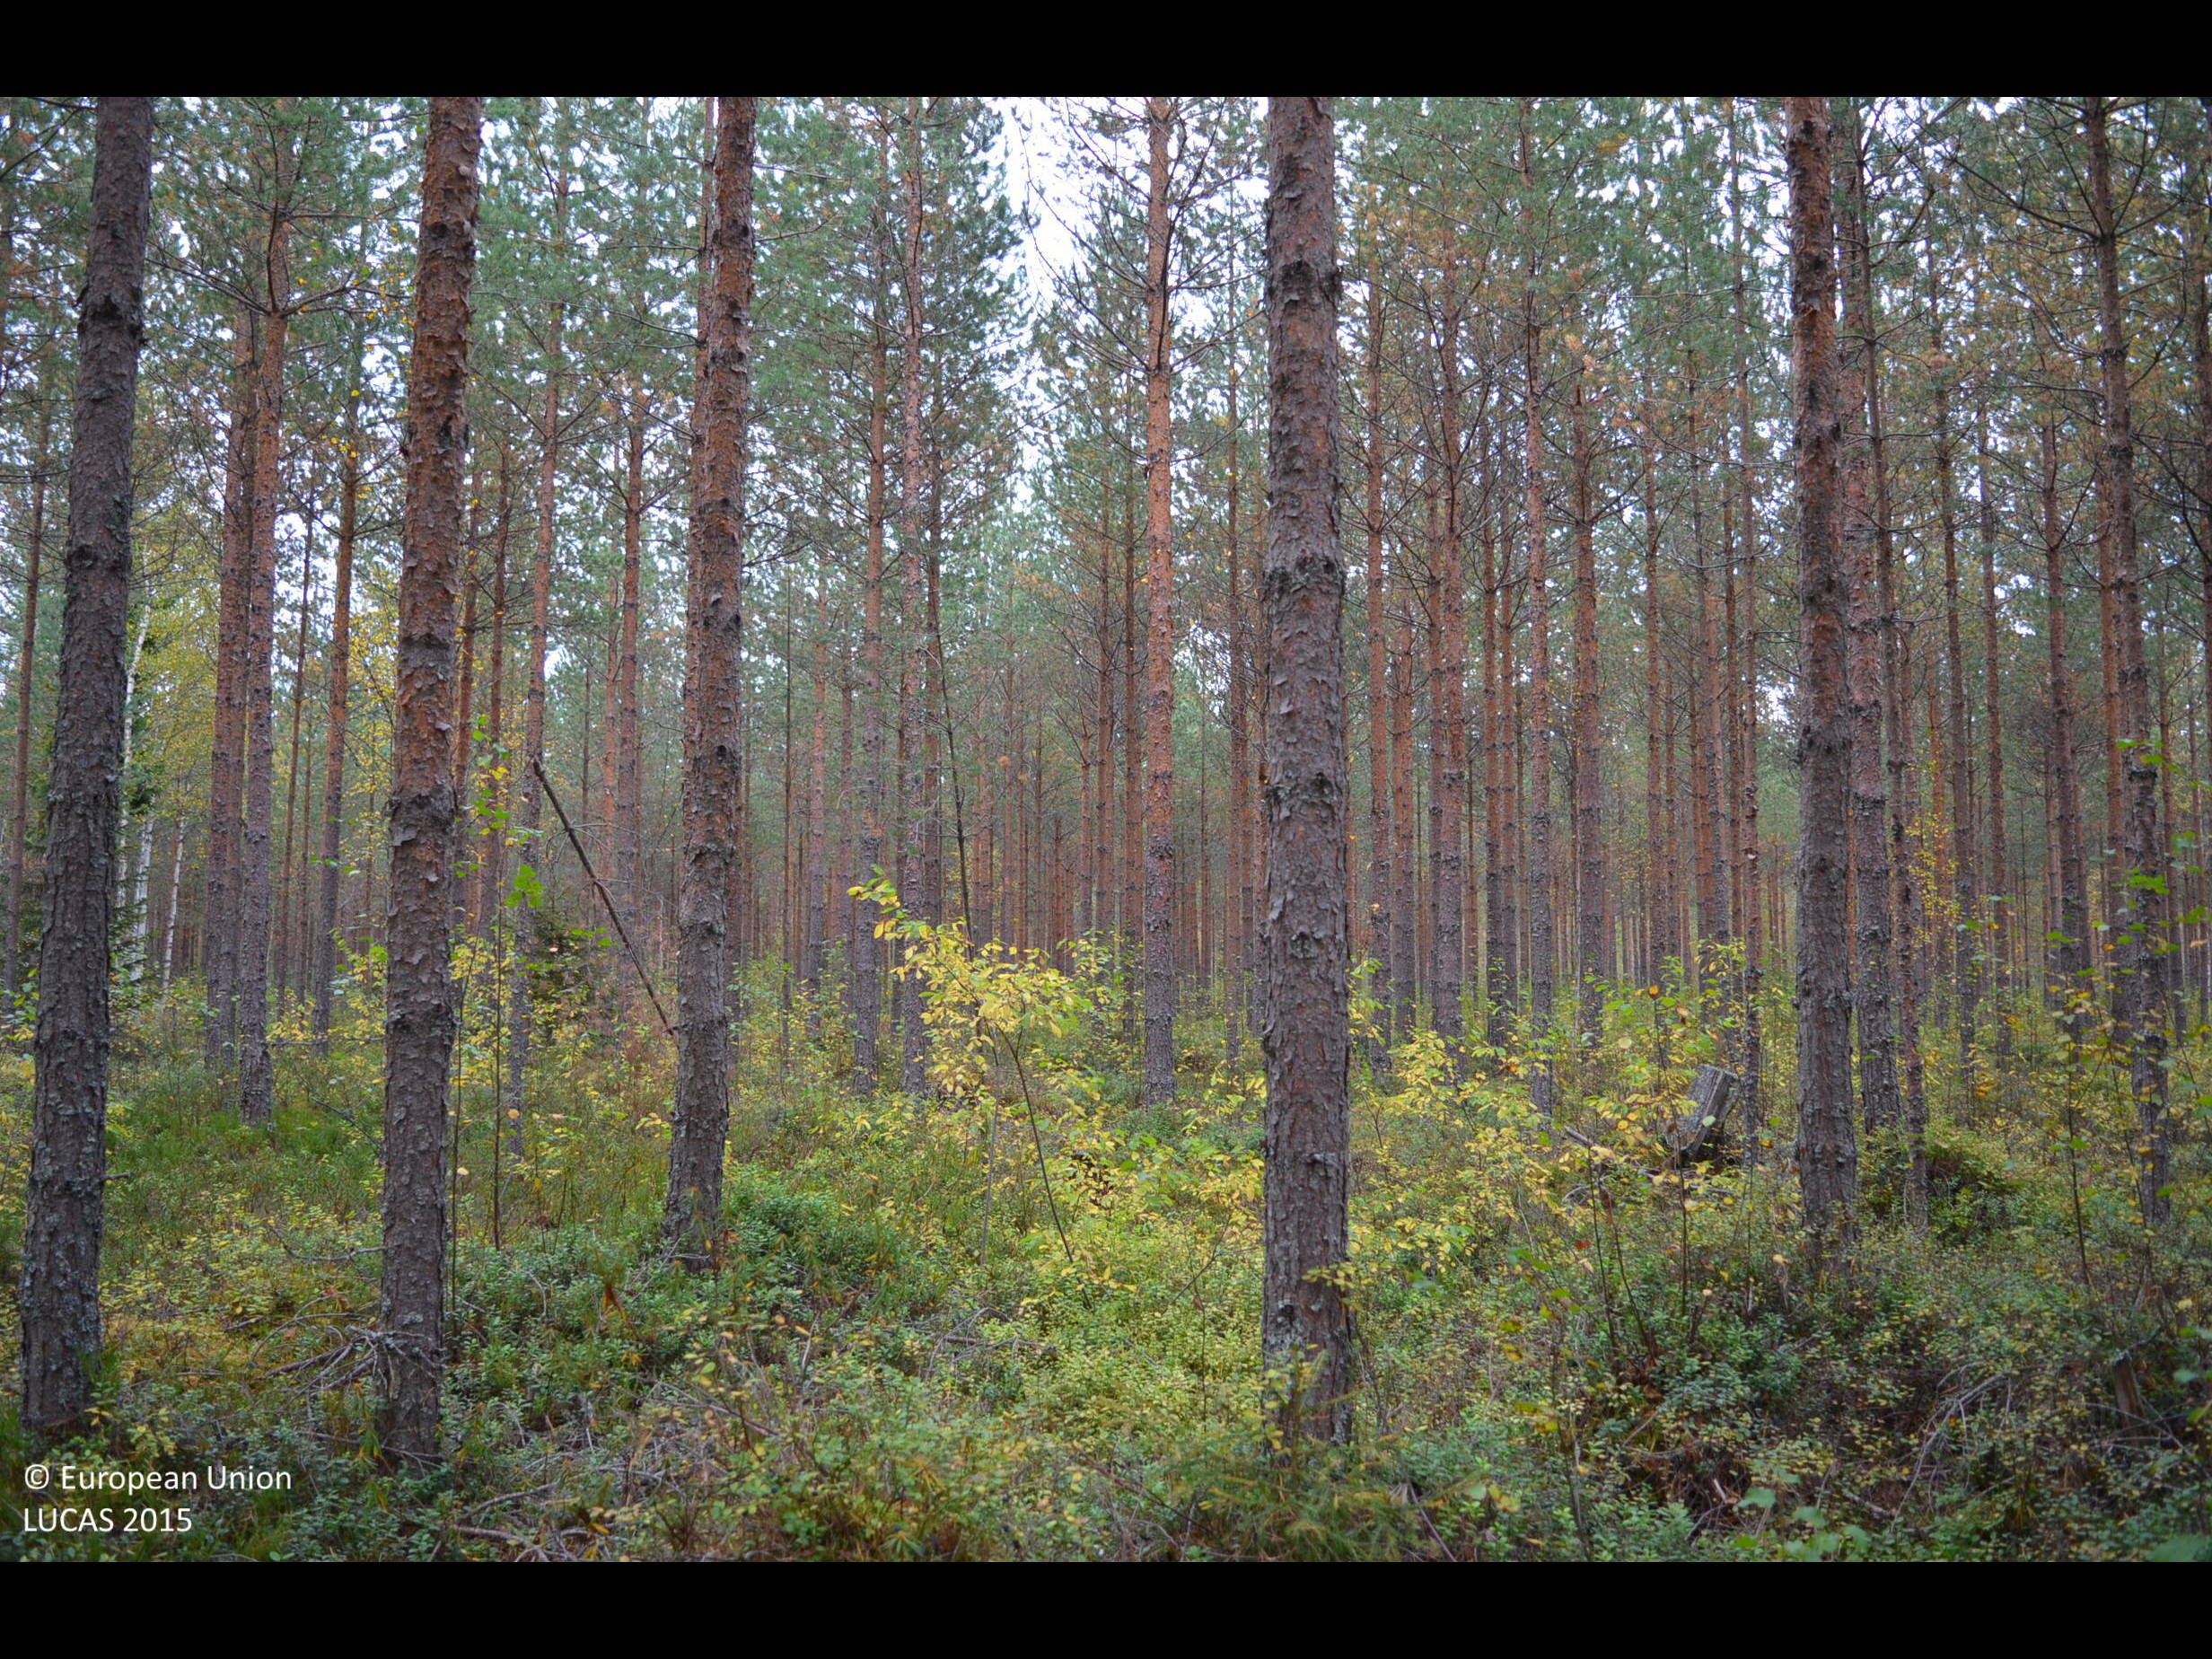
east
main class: Woodland
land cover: Pine dominated coniferous woodland
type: boreal forest
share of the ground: > 75 %
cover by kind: coniferous forest trees 75 %, shrubs 20 %, broadleaved forest trees 5 %
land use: Forestry
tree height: > 5 m
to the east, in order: Pine dominated coniferous woodland; Ditches and canals; Pine dominated coniferous woodland; Ditches and canals; Pine dominated coniferous woodland; Ditches and canals; Pine dominated coniferous woodland; Ditches and canals; Pine dominated coniferous woodland; Ditches and canals; Pine dominated mixed woodland; Ditches and canals; Pine dominated mixed woodland; Ditches and canals; Pine dominated mixed woodland; Ditches and canals; Pine dominated mixed woodland
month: September
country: FI
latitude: 62.8466
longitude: 23.8821
